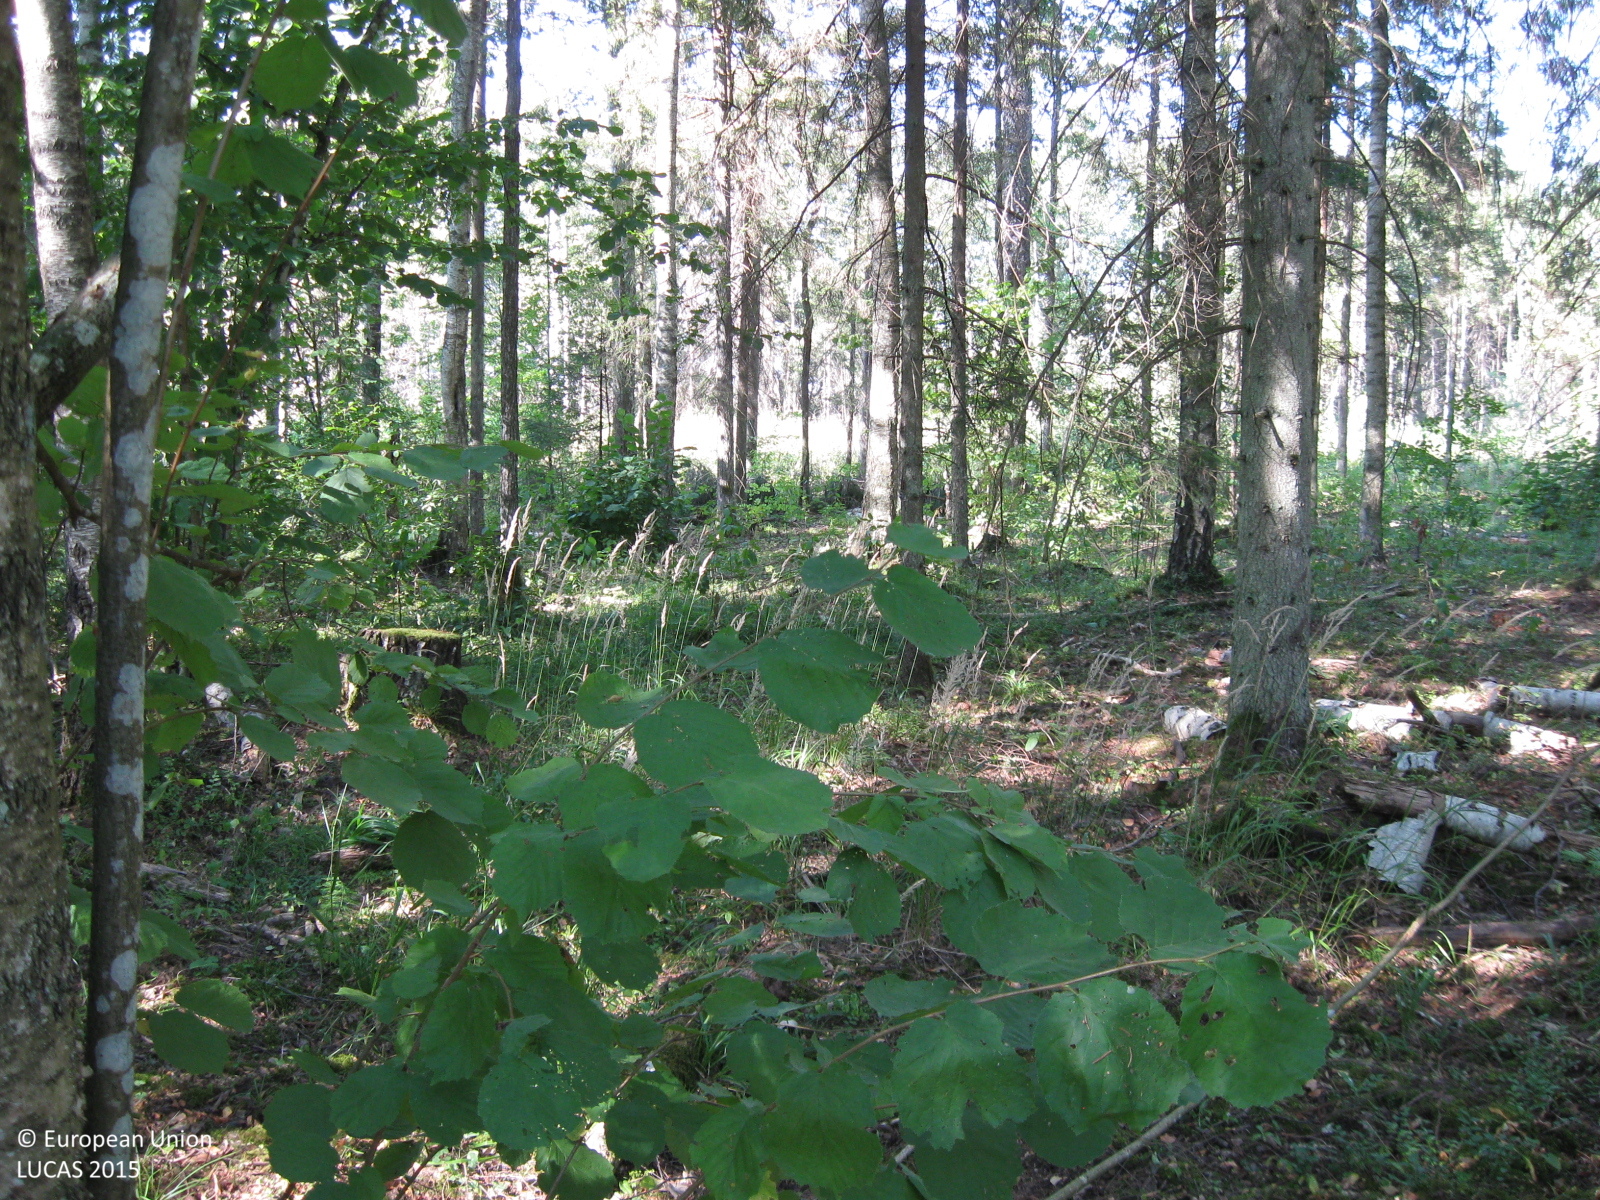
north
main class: Woodland
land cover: Spruce dominated mixed woodland
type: hemiboreal forest and nemoral coniferous forest and mixed broadleaved-coniferous forest
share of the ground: > 75 %
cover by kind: broadleaved forest trees 45 %, coniferous forest trees 40 %, herbaceous plants 10 %, lichens and mosses 5 %
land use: Forestry
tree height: > 5 m
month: August
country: LT
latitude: 55.3096
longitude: 22.5881
